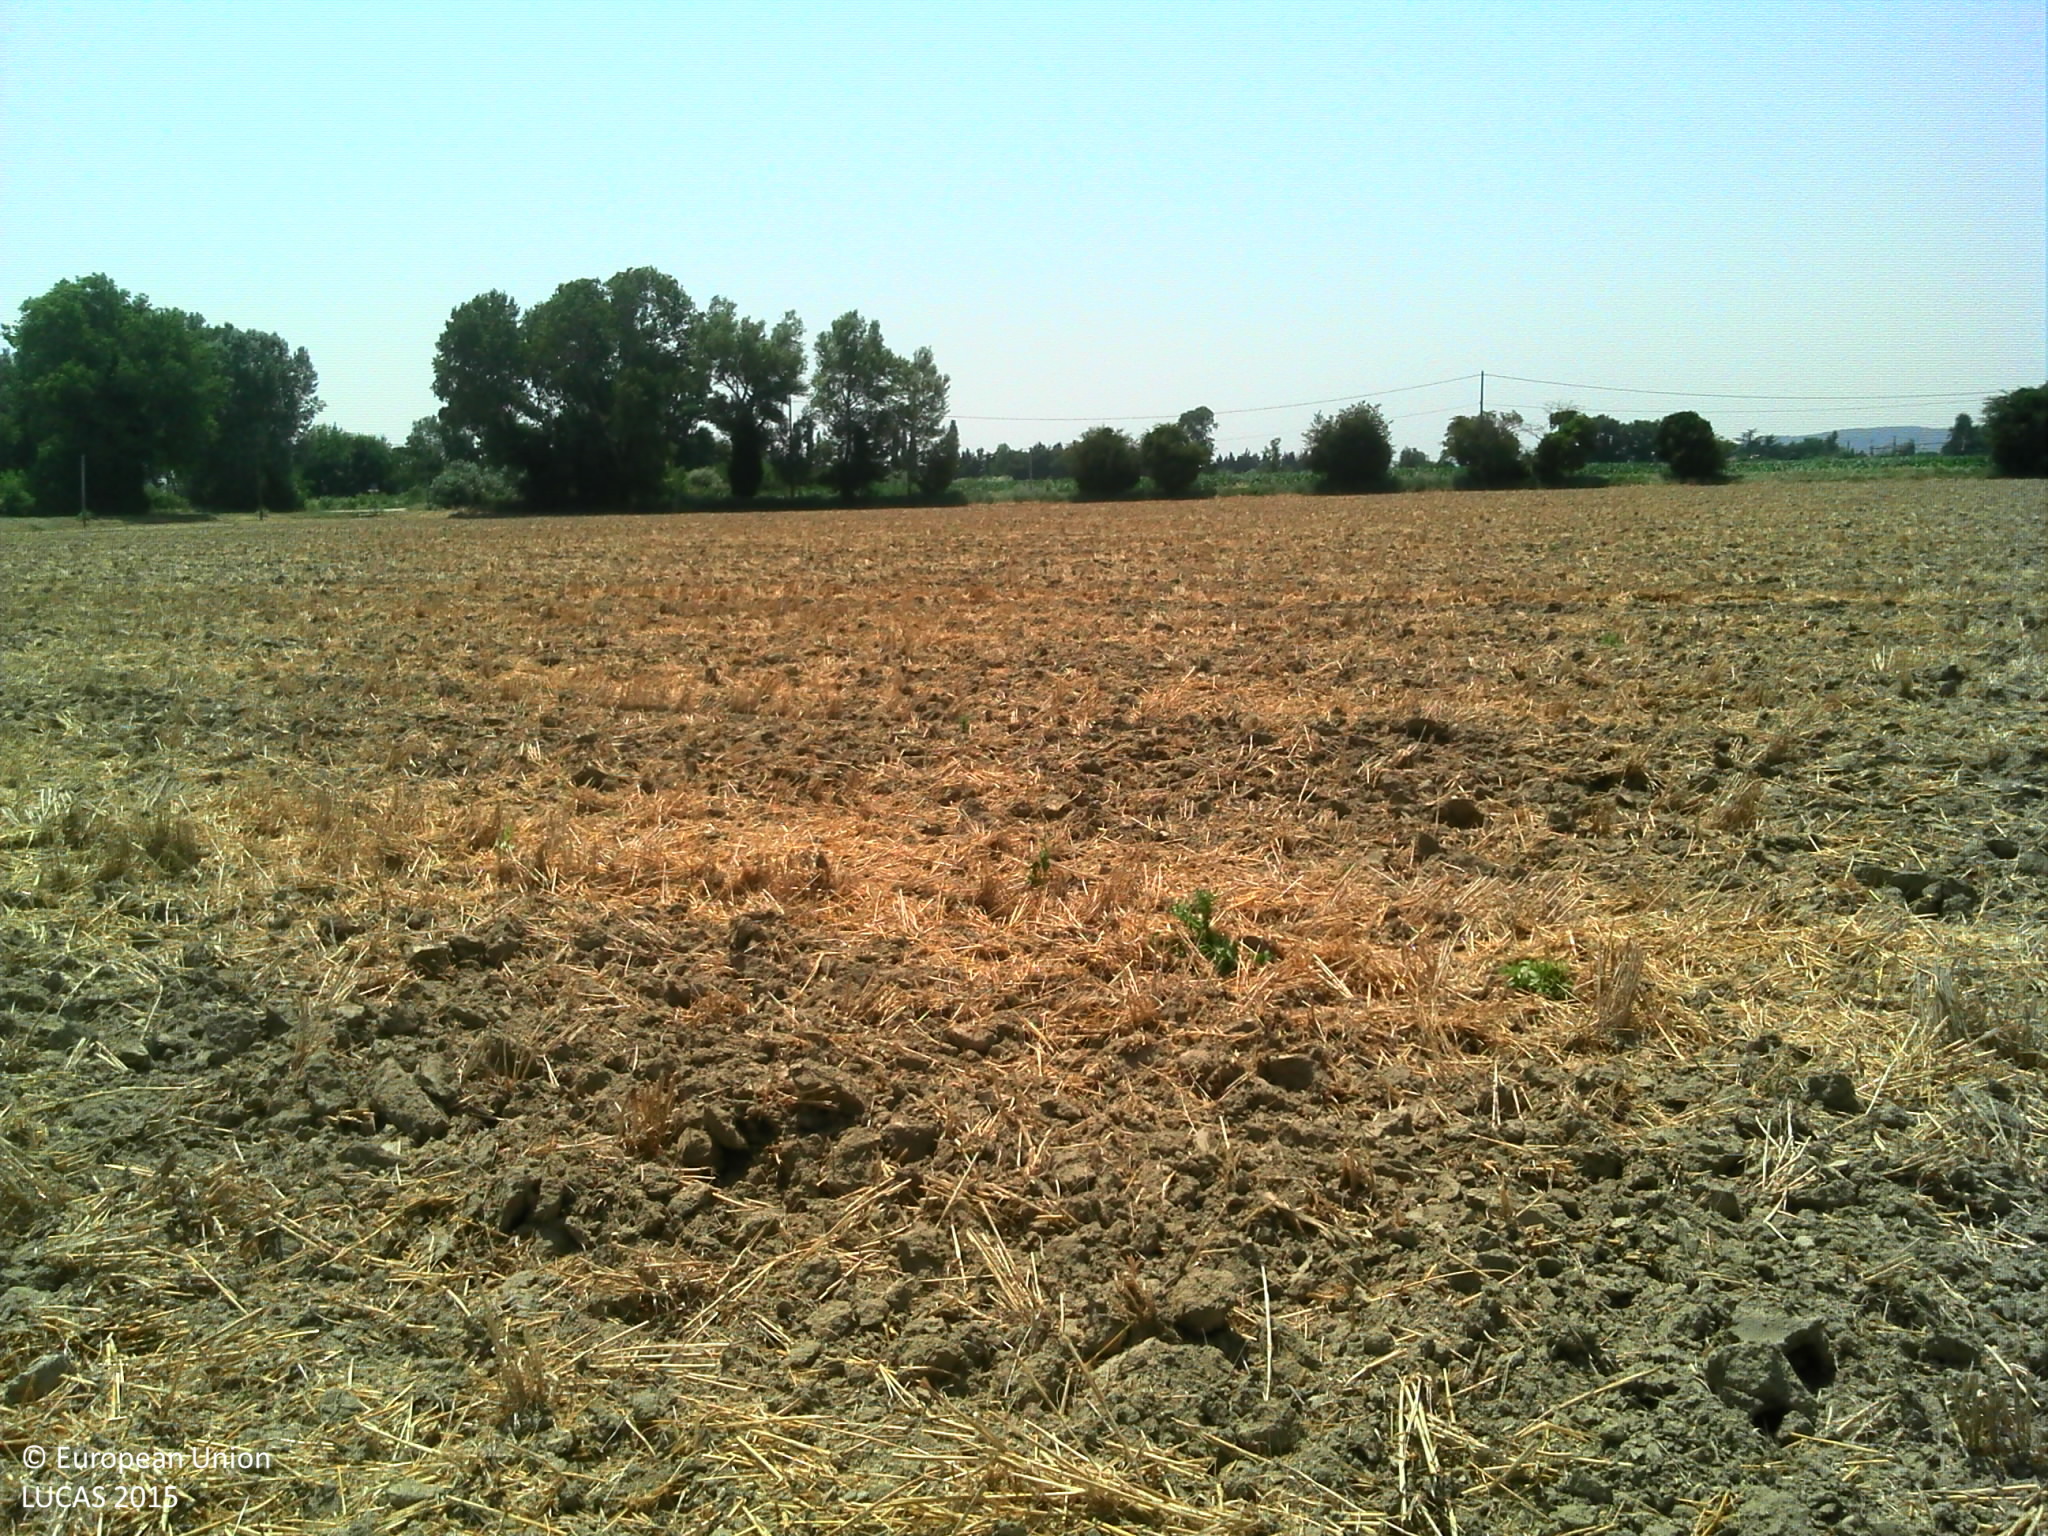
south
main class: Cropland
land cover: Barley
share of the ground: > 75 %
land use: Agriculture (excluding fallow land and kitchen gardens)
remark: Harvested field
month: July
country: FR
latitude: 44.3944
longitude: 4.6715
